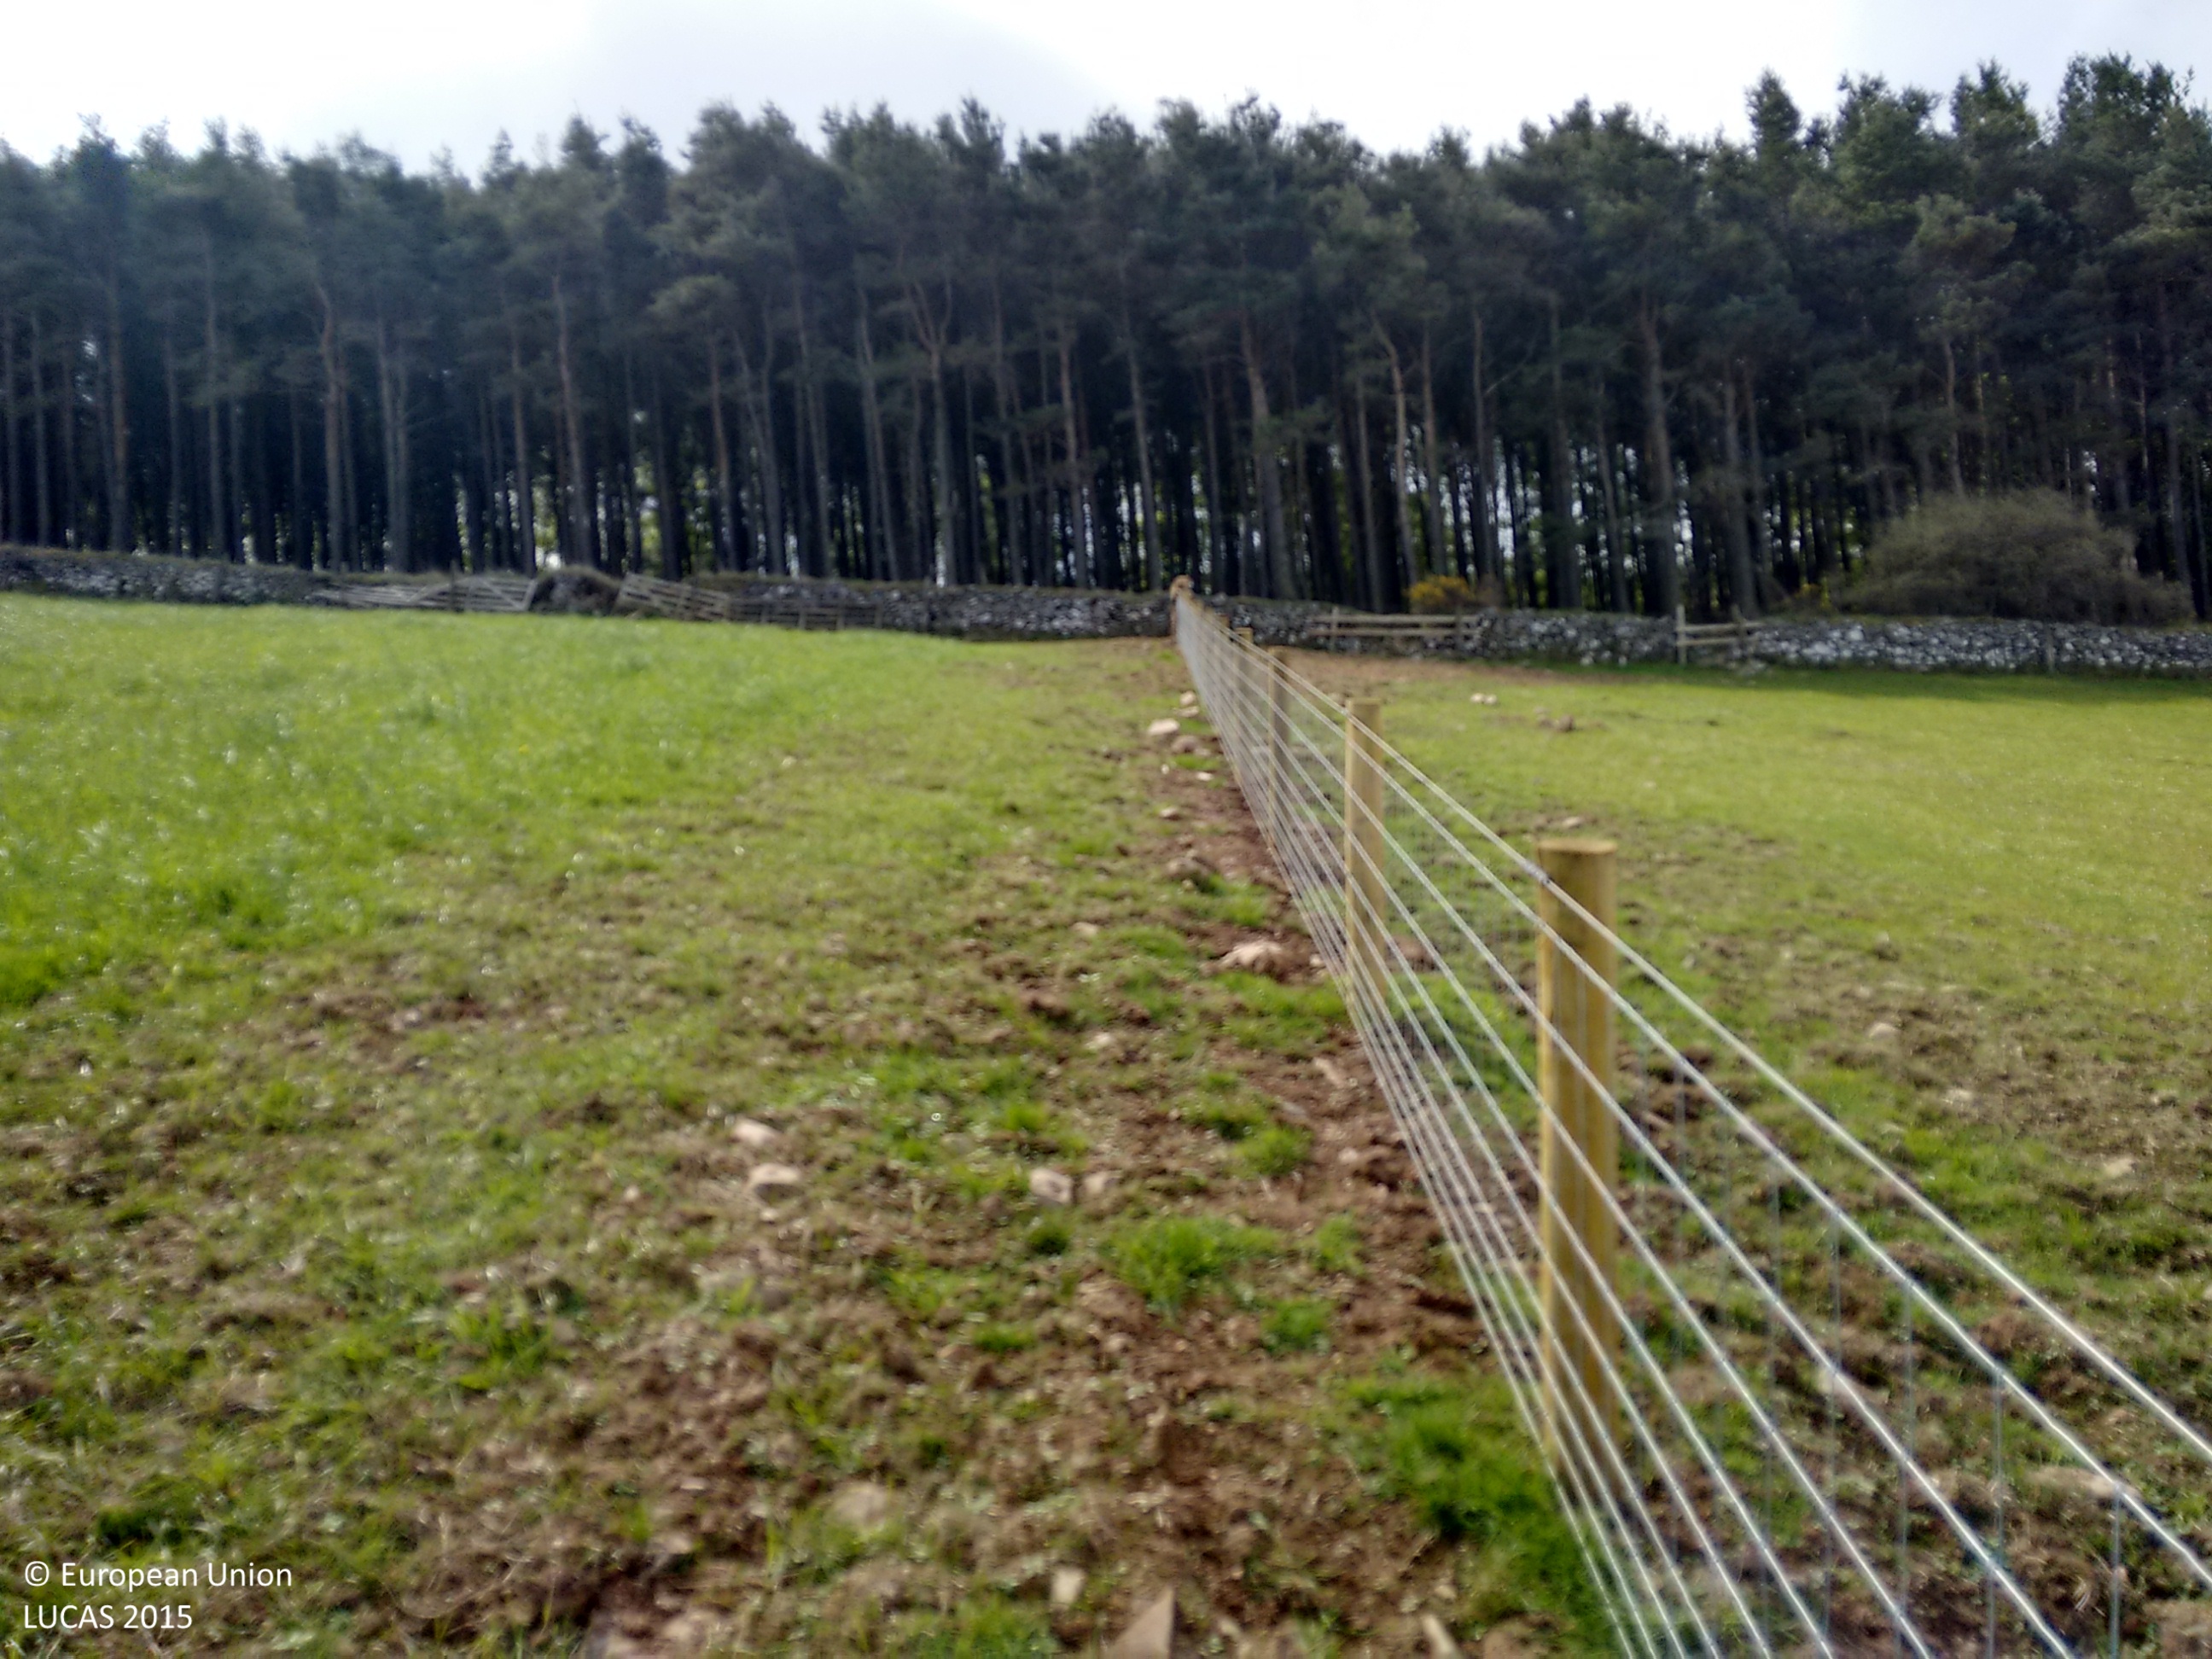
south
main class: Grassland
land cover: Grassland without tree/shrub cover
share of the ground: > 75 %
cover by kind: herbaceous plants 100 %
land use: Agriculture (excluding fallow land and kitchen gardens)
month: May
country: GB
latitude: 55.8268
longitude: -2.3329
